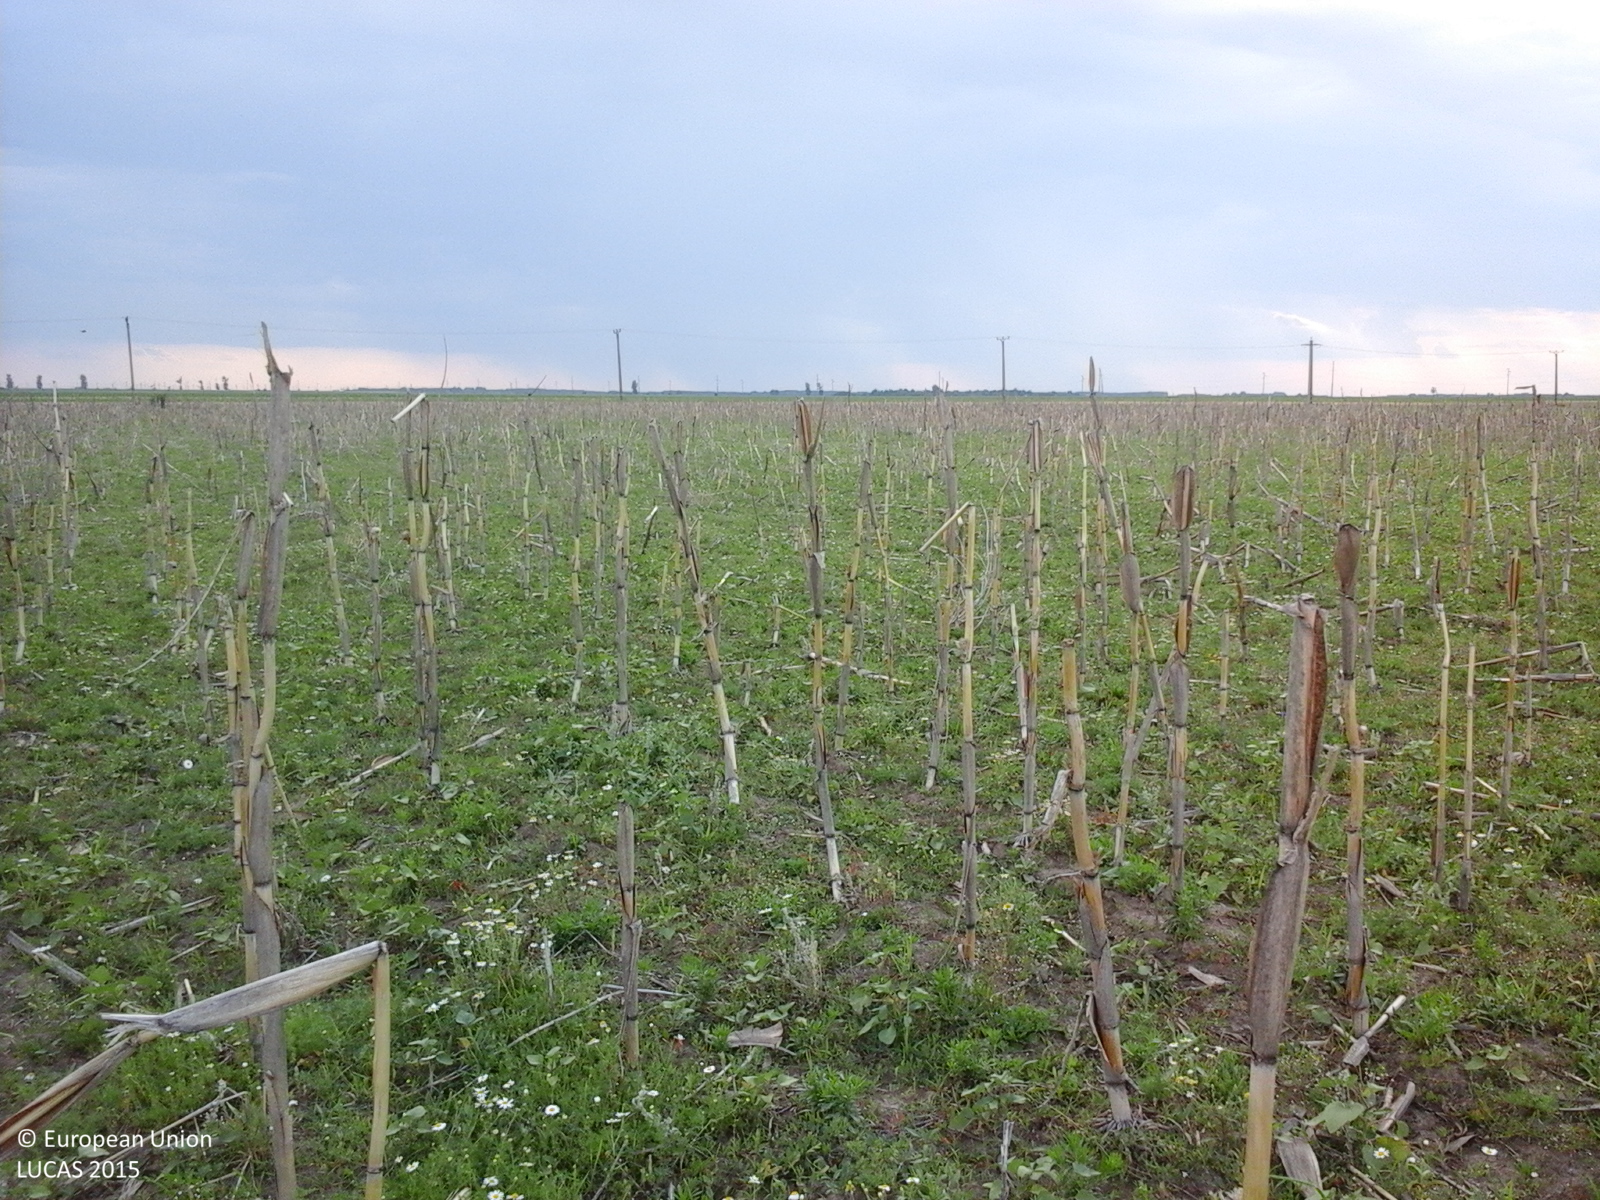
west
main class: Grassland
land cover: Spontaneously vegetated surfaces
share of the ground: > 75 %
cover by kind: herbaceous plants 100 %
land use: Agriculture (excluding fallow land and kitchen gardens)
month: July
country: RO
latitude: 44.3053
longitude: 25.3163
